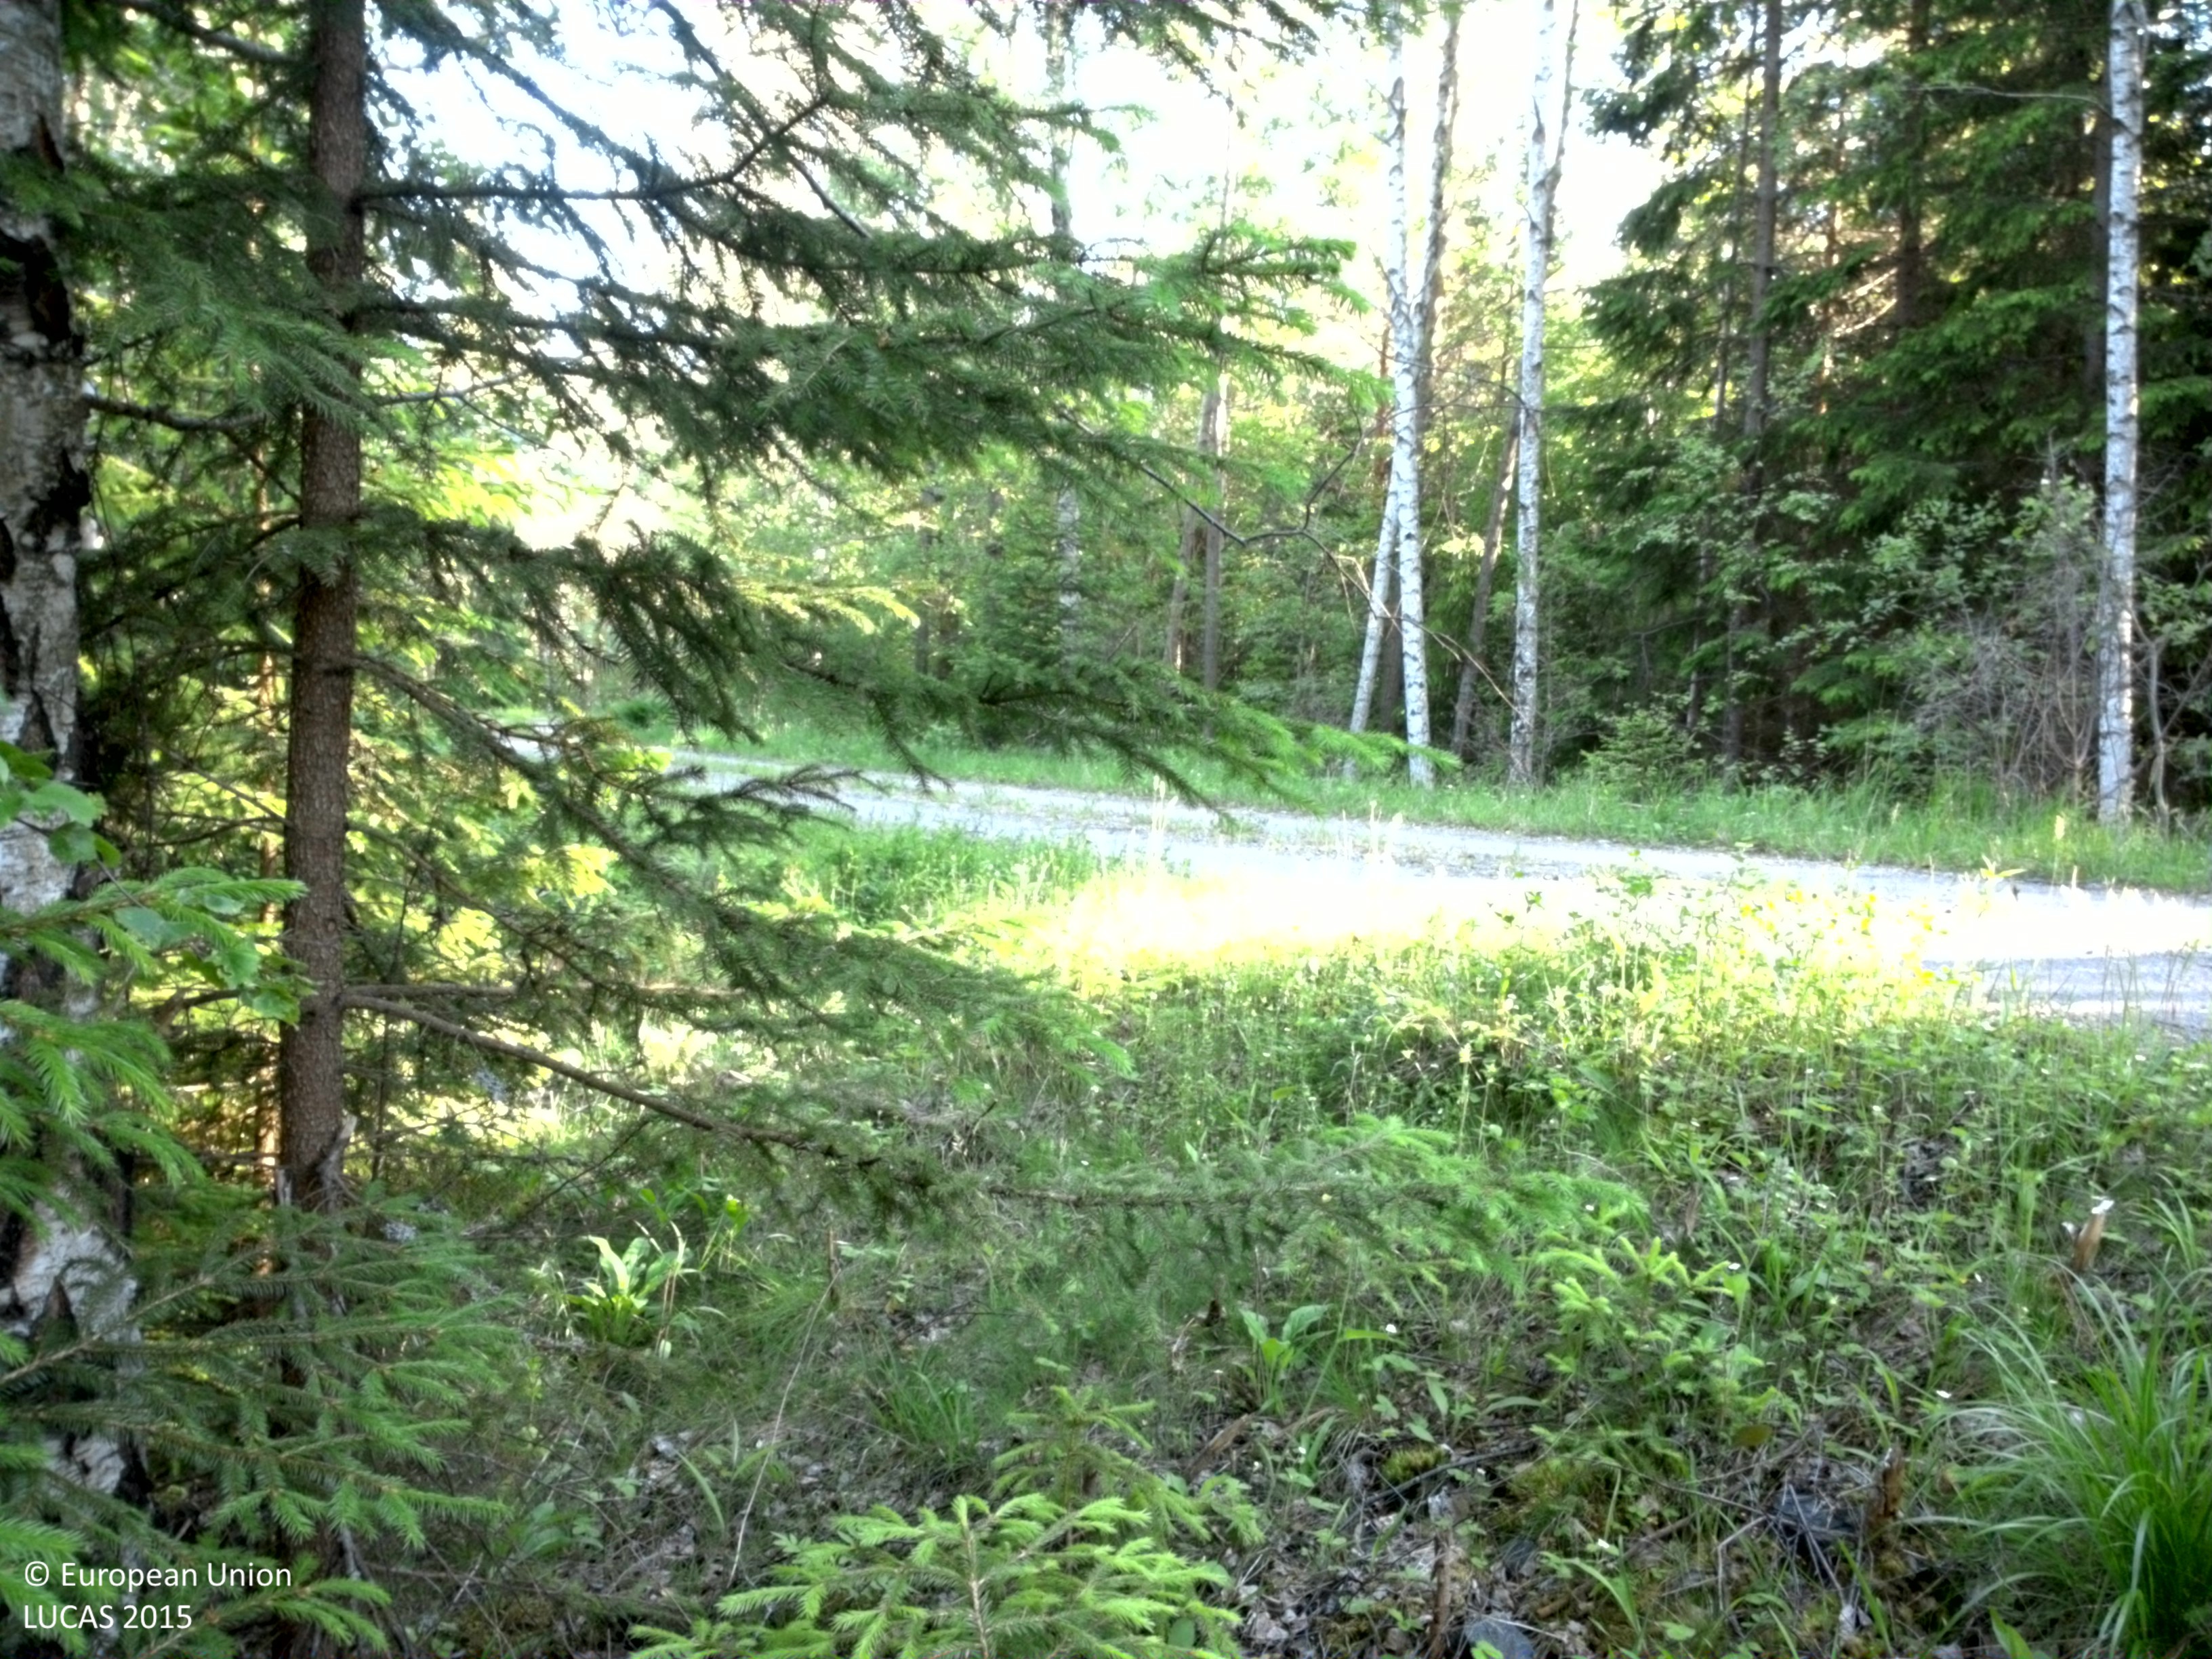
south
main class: Woodland
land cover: Spruce dominated mixed woodland
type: boreal forest
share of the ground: 50 - 75 %
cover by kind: coniferous forest trees 50 %, broadleaved forest trees 25 %, herbaceous plants 20 %, shrubs 5 %
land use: Forestry
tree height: > 5 m
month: June
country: SE
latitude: 58.6636
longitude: 14.5960
